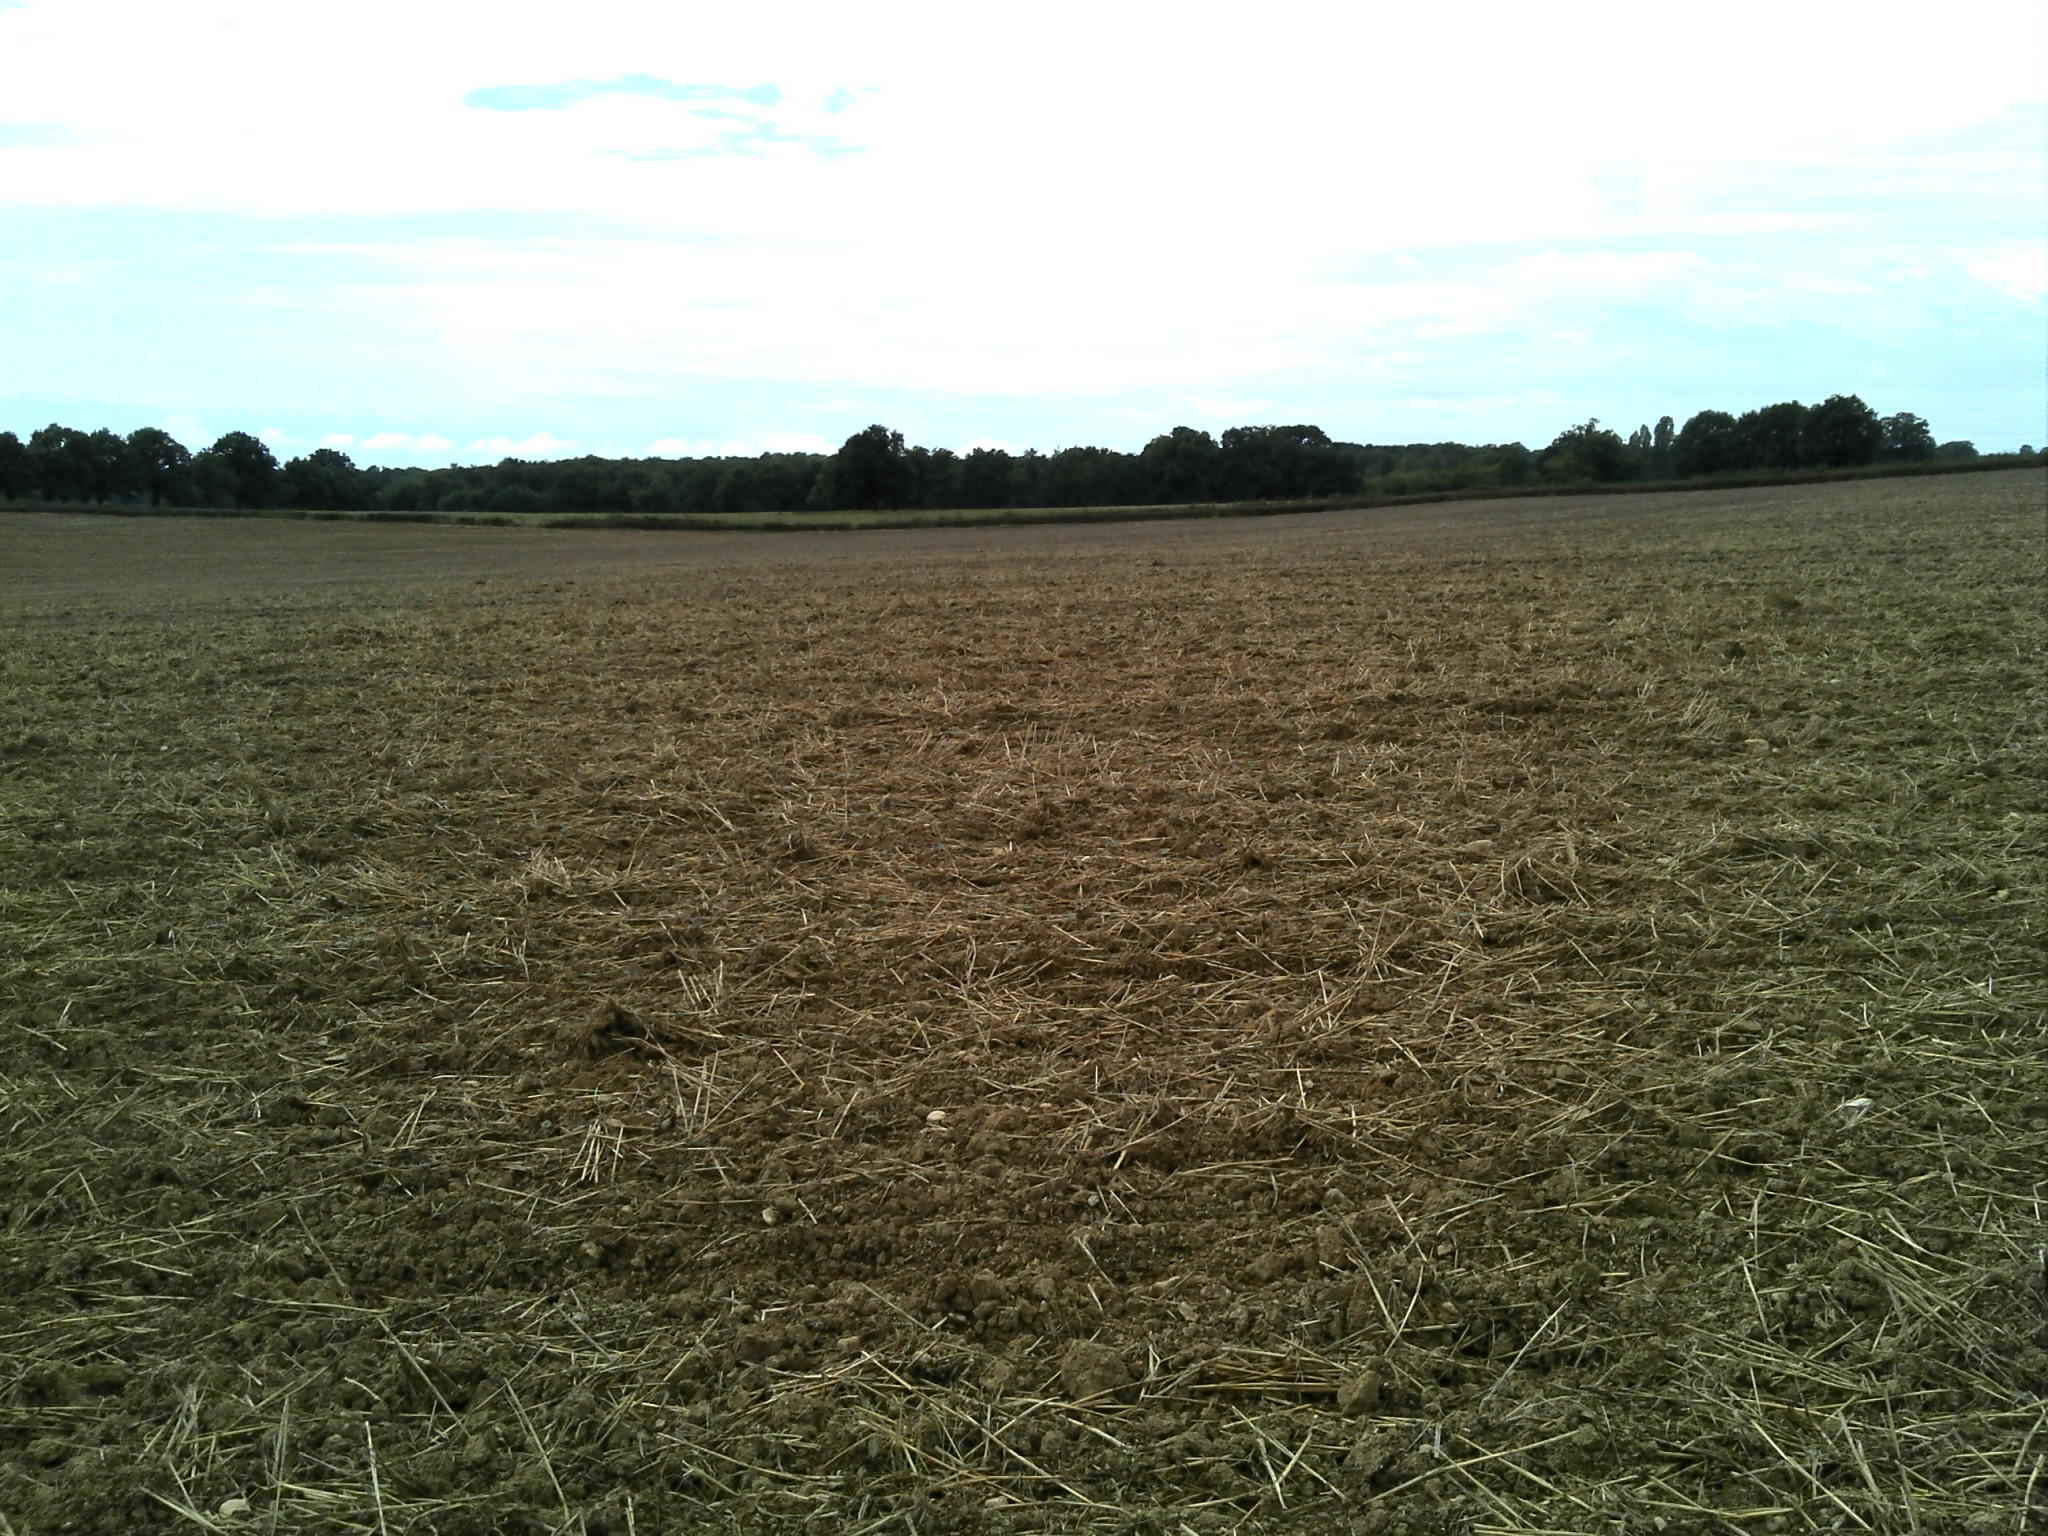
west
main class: Cropland
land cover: Common wheat
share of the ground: > 75 %
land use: Agriculture (excluding fallow land and kitchen gardens)
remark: Tilled/Sowed
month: August
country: FR
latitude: 46.6247
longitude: 2.1700
